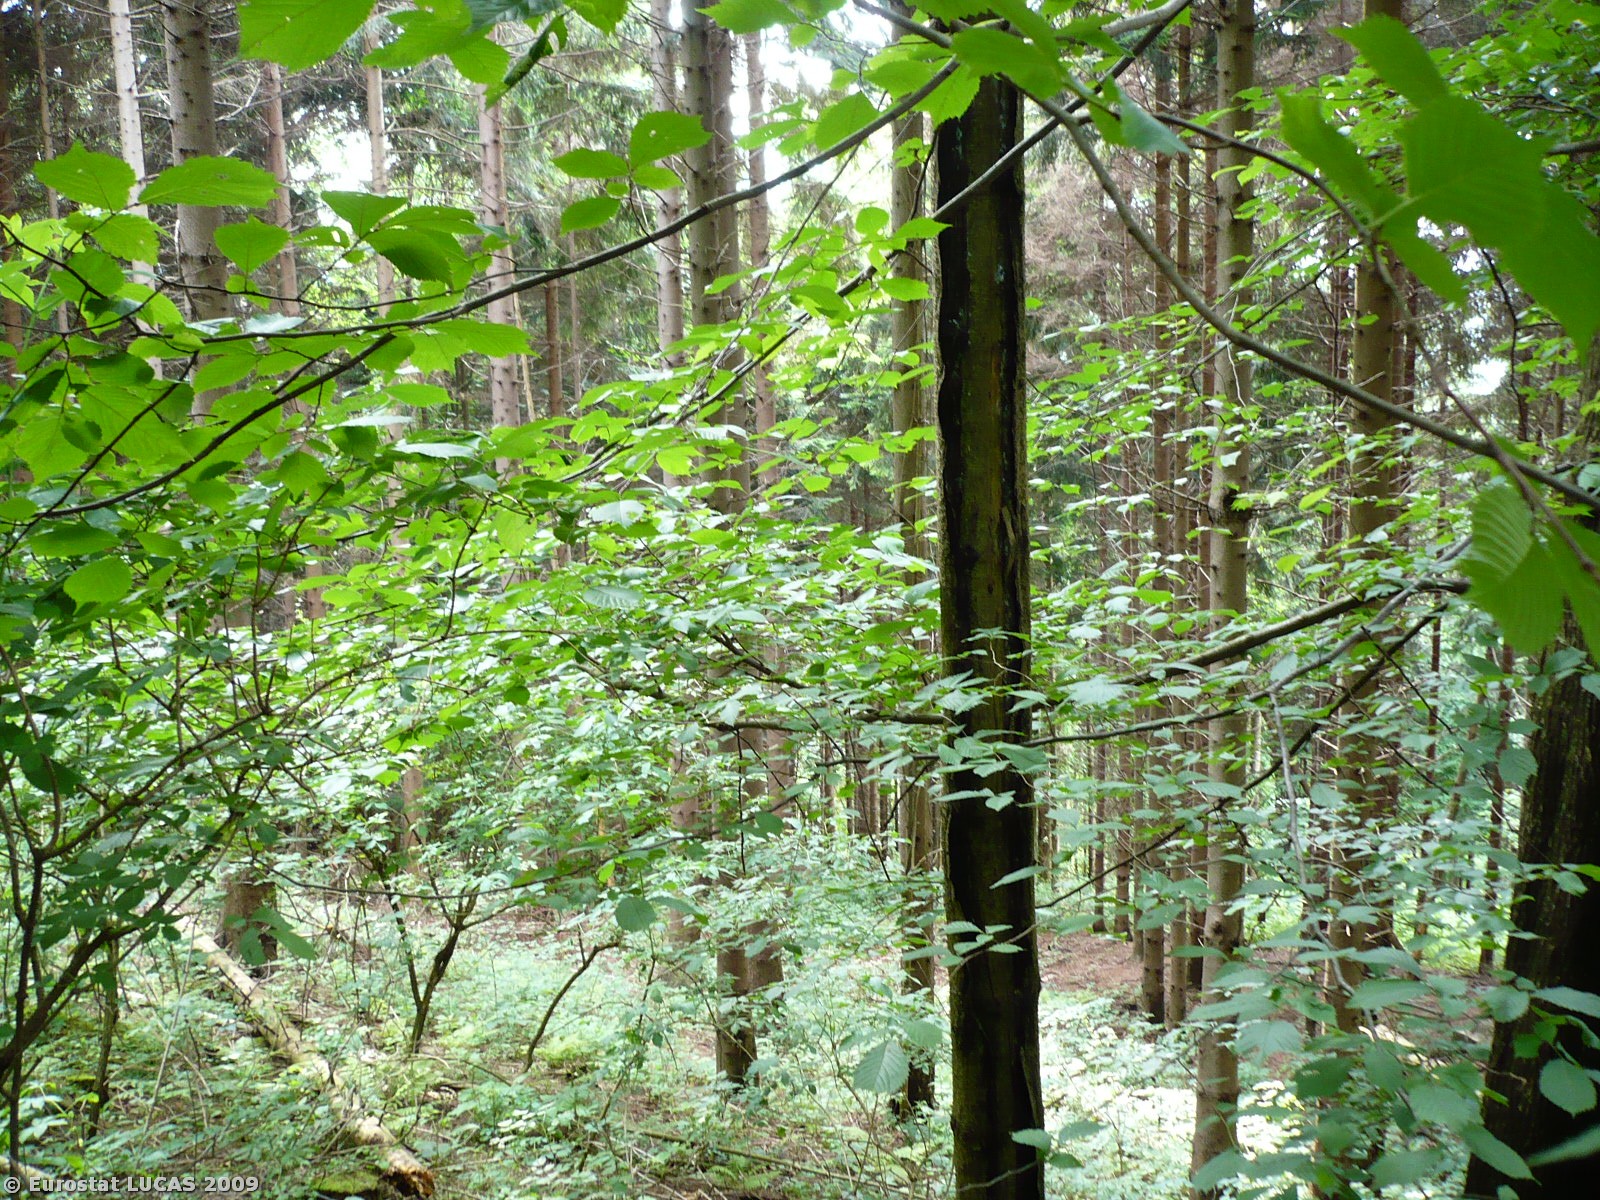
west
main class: Woodland
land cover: Mixed woodland
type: beech forest
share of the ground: > 75 %
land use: Forestry
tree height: > 5 m
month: June
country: SI
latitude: 46.0724
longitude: 13.6553
